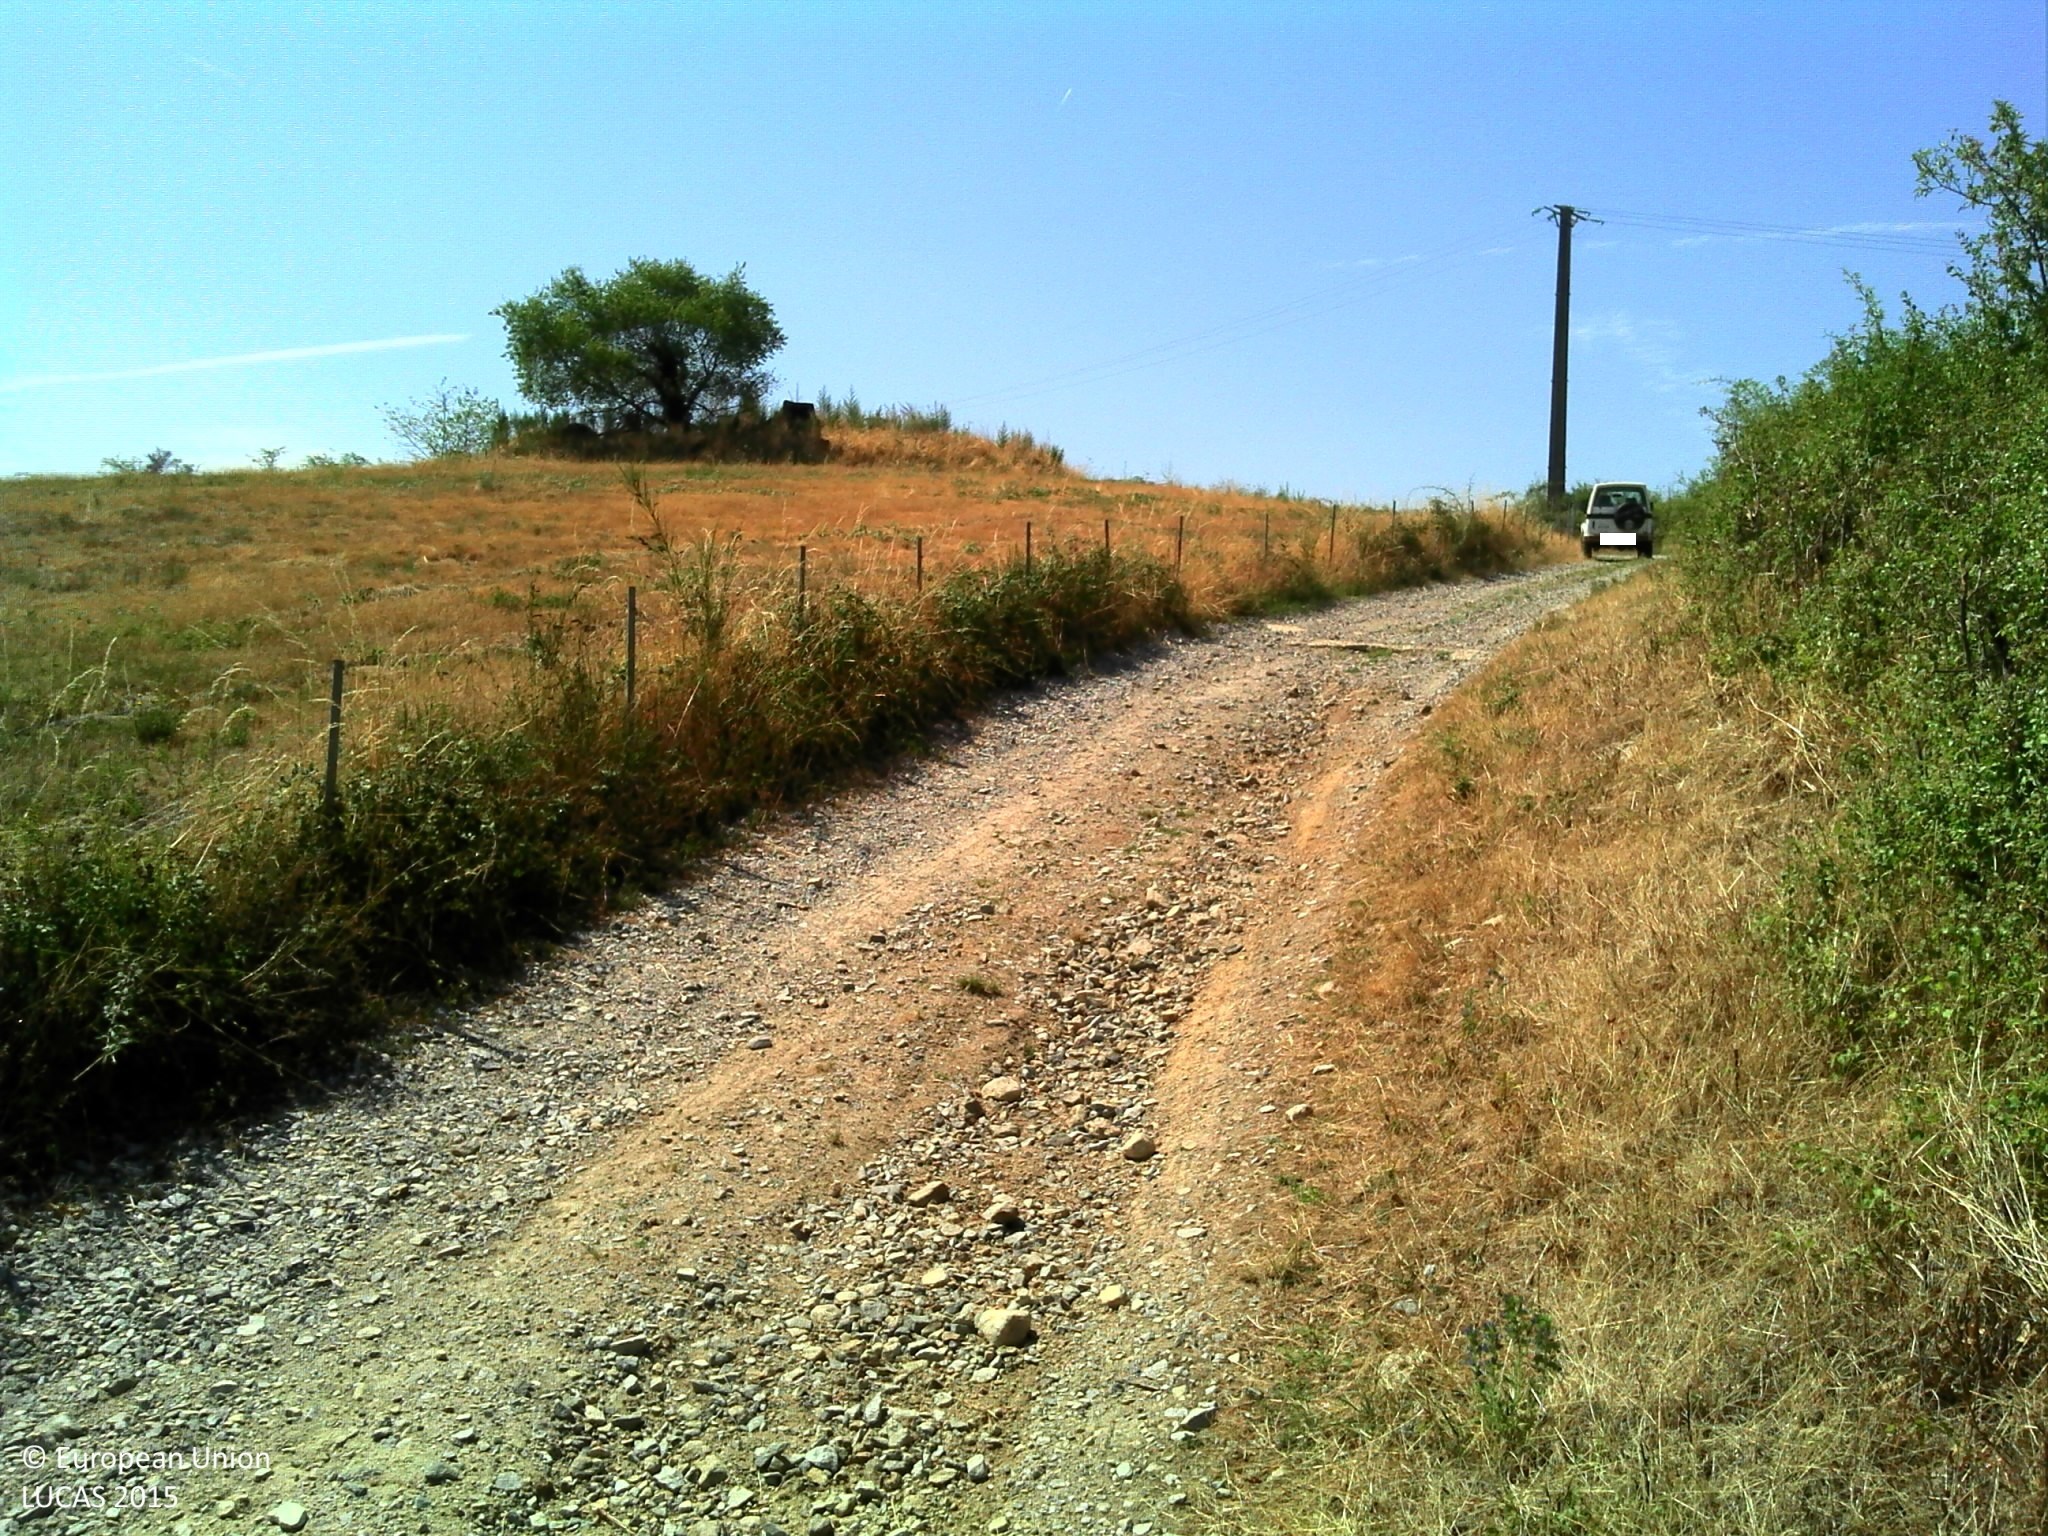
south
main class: Grassland
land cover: Grassland without tree/shrub cover
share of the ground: > 75 %
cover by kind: herbaceous plants 90 %, unconsolidated bare surface 10 %
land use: Agriculture (excluding fallow land and kitchen gardens)
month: August
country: FR
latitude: 45.5102
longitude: 4.5895
